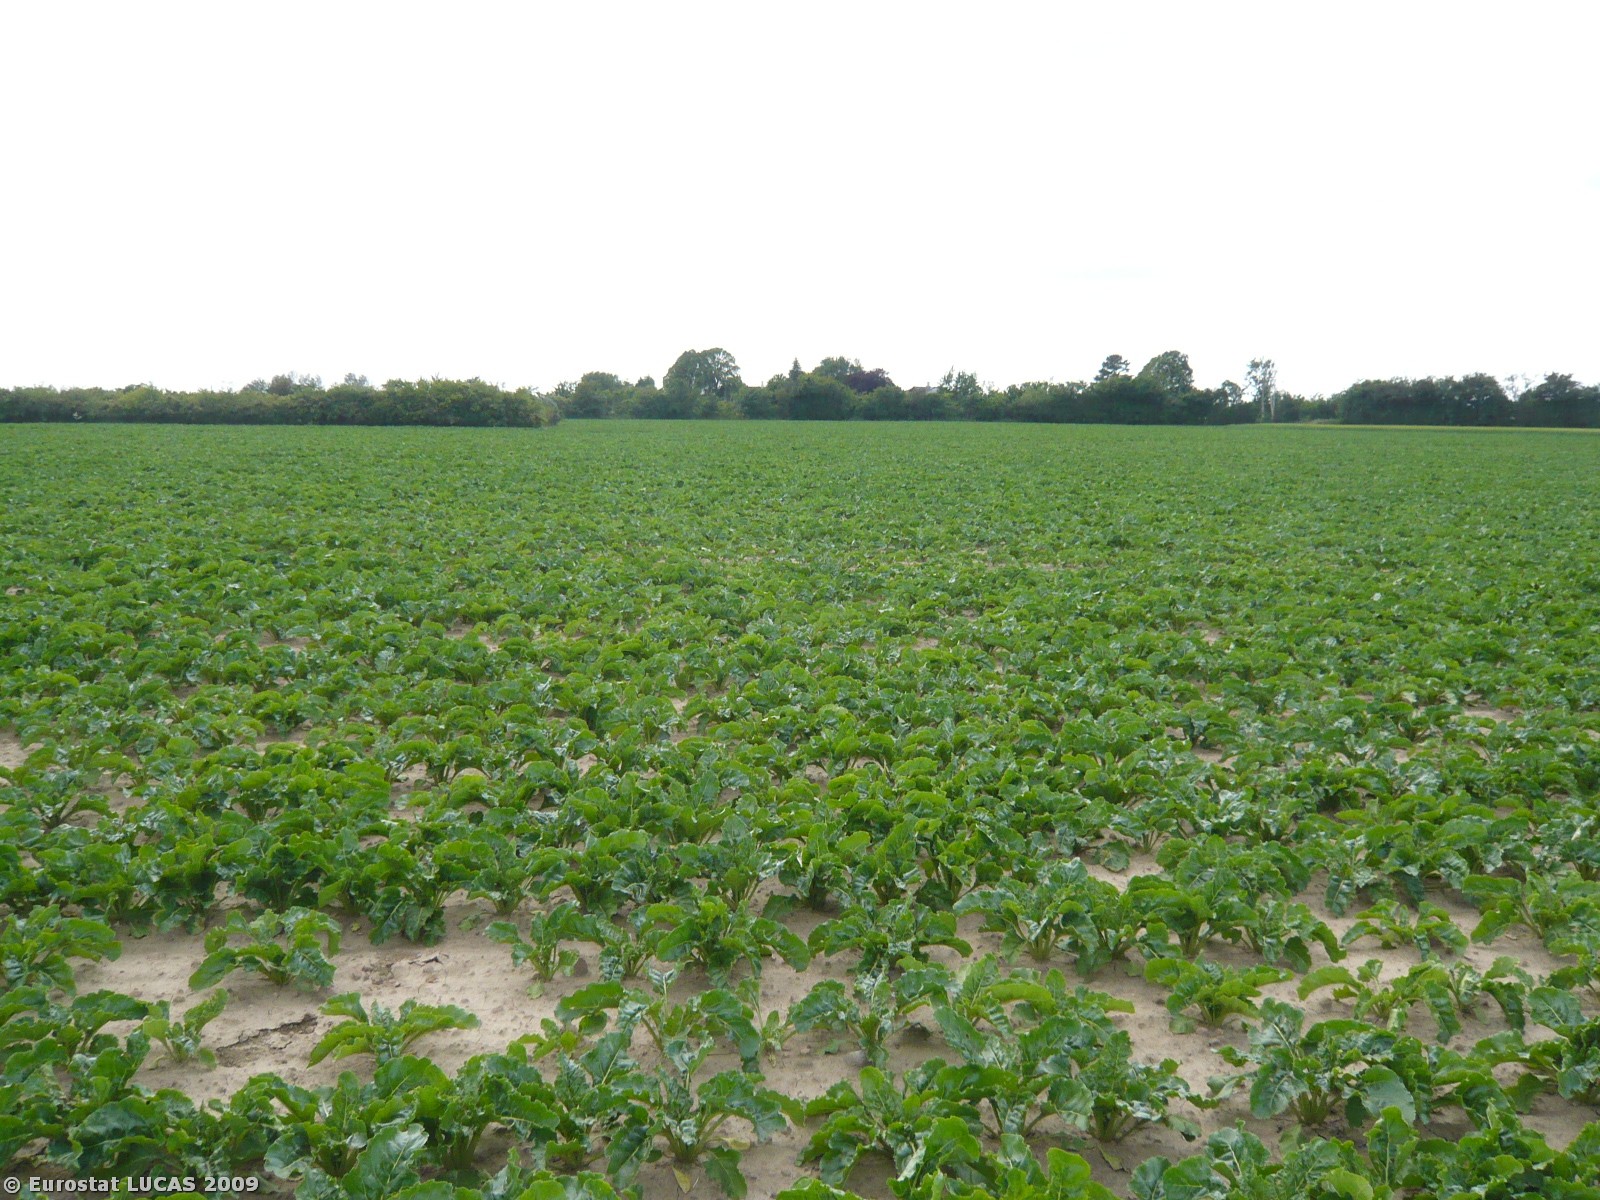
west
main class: Cropland
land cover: Sugar beet
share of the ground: > 75 %
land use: Agriculture (excluding fallow land and kitchen gardens)
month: June
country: DK
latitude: 54.7591
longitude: 11.4753
